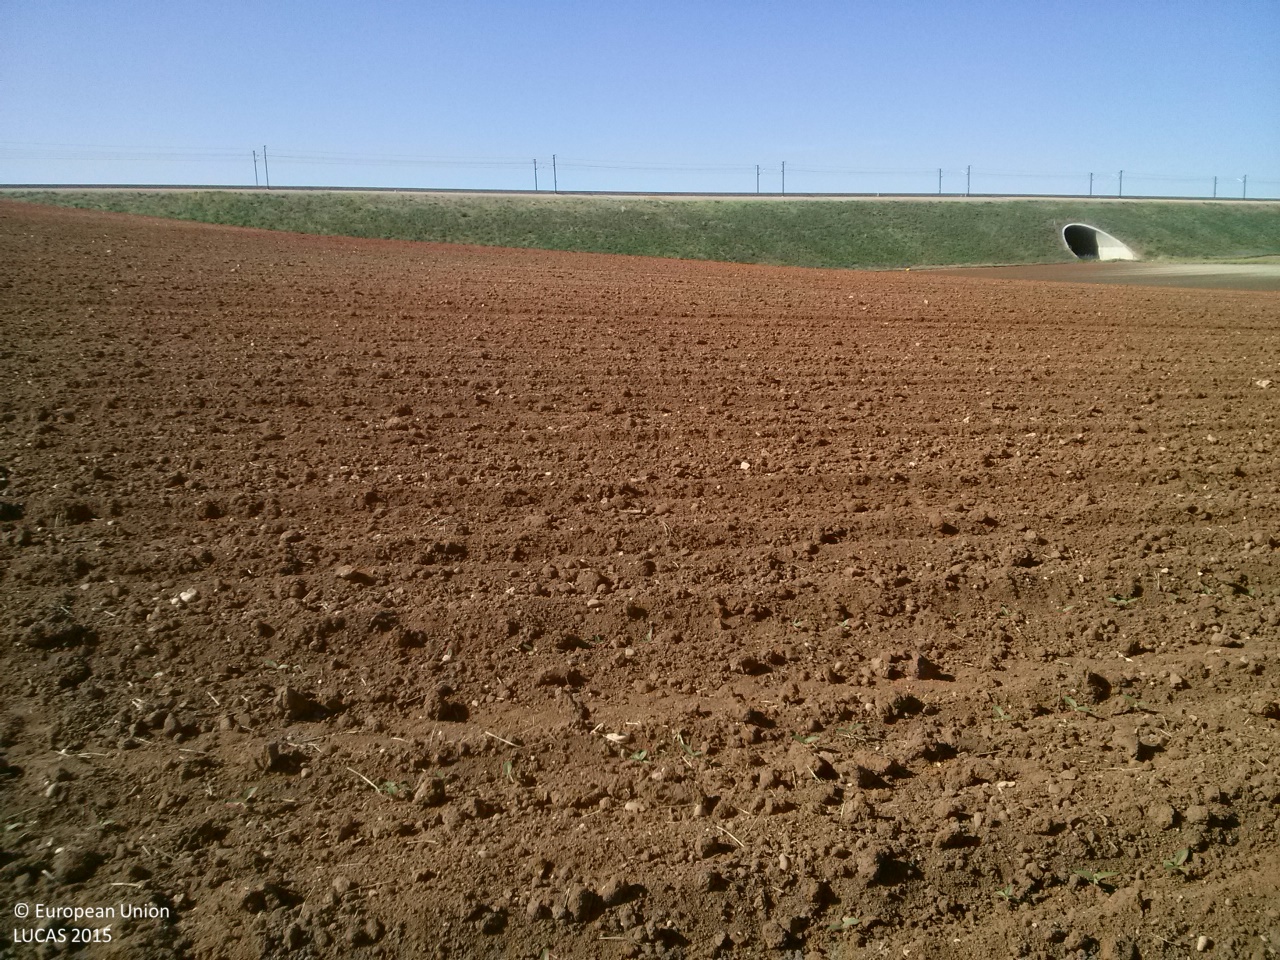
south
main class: Cropland
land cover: Sunflower
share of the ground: < 10 %
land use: Agriculture (excluding fallow land and kitchen gardens)
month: May
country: ES
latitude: 40.0280
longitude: -2.8062
